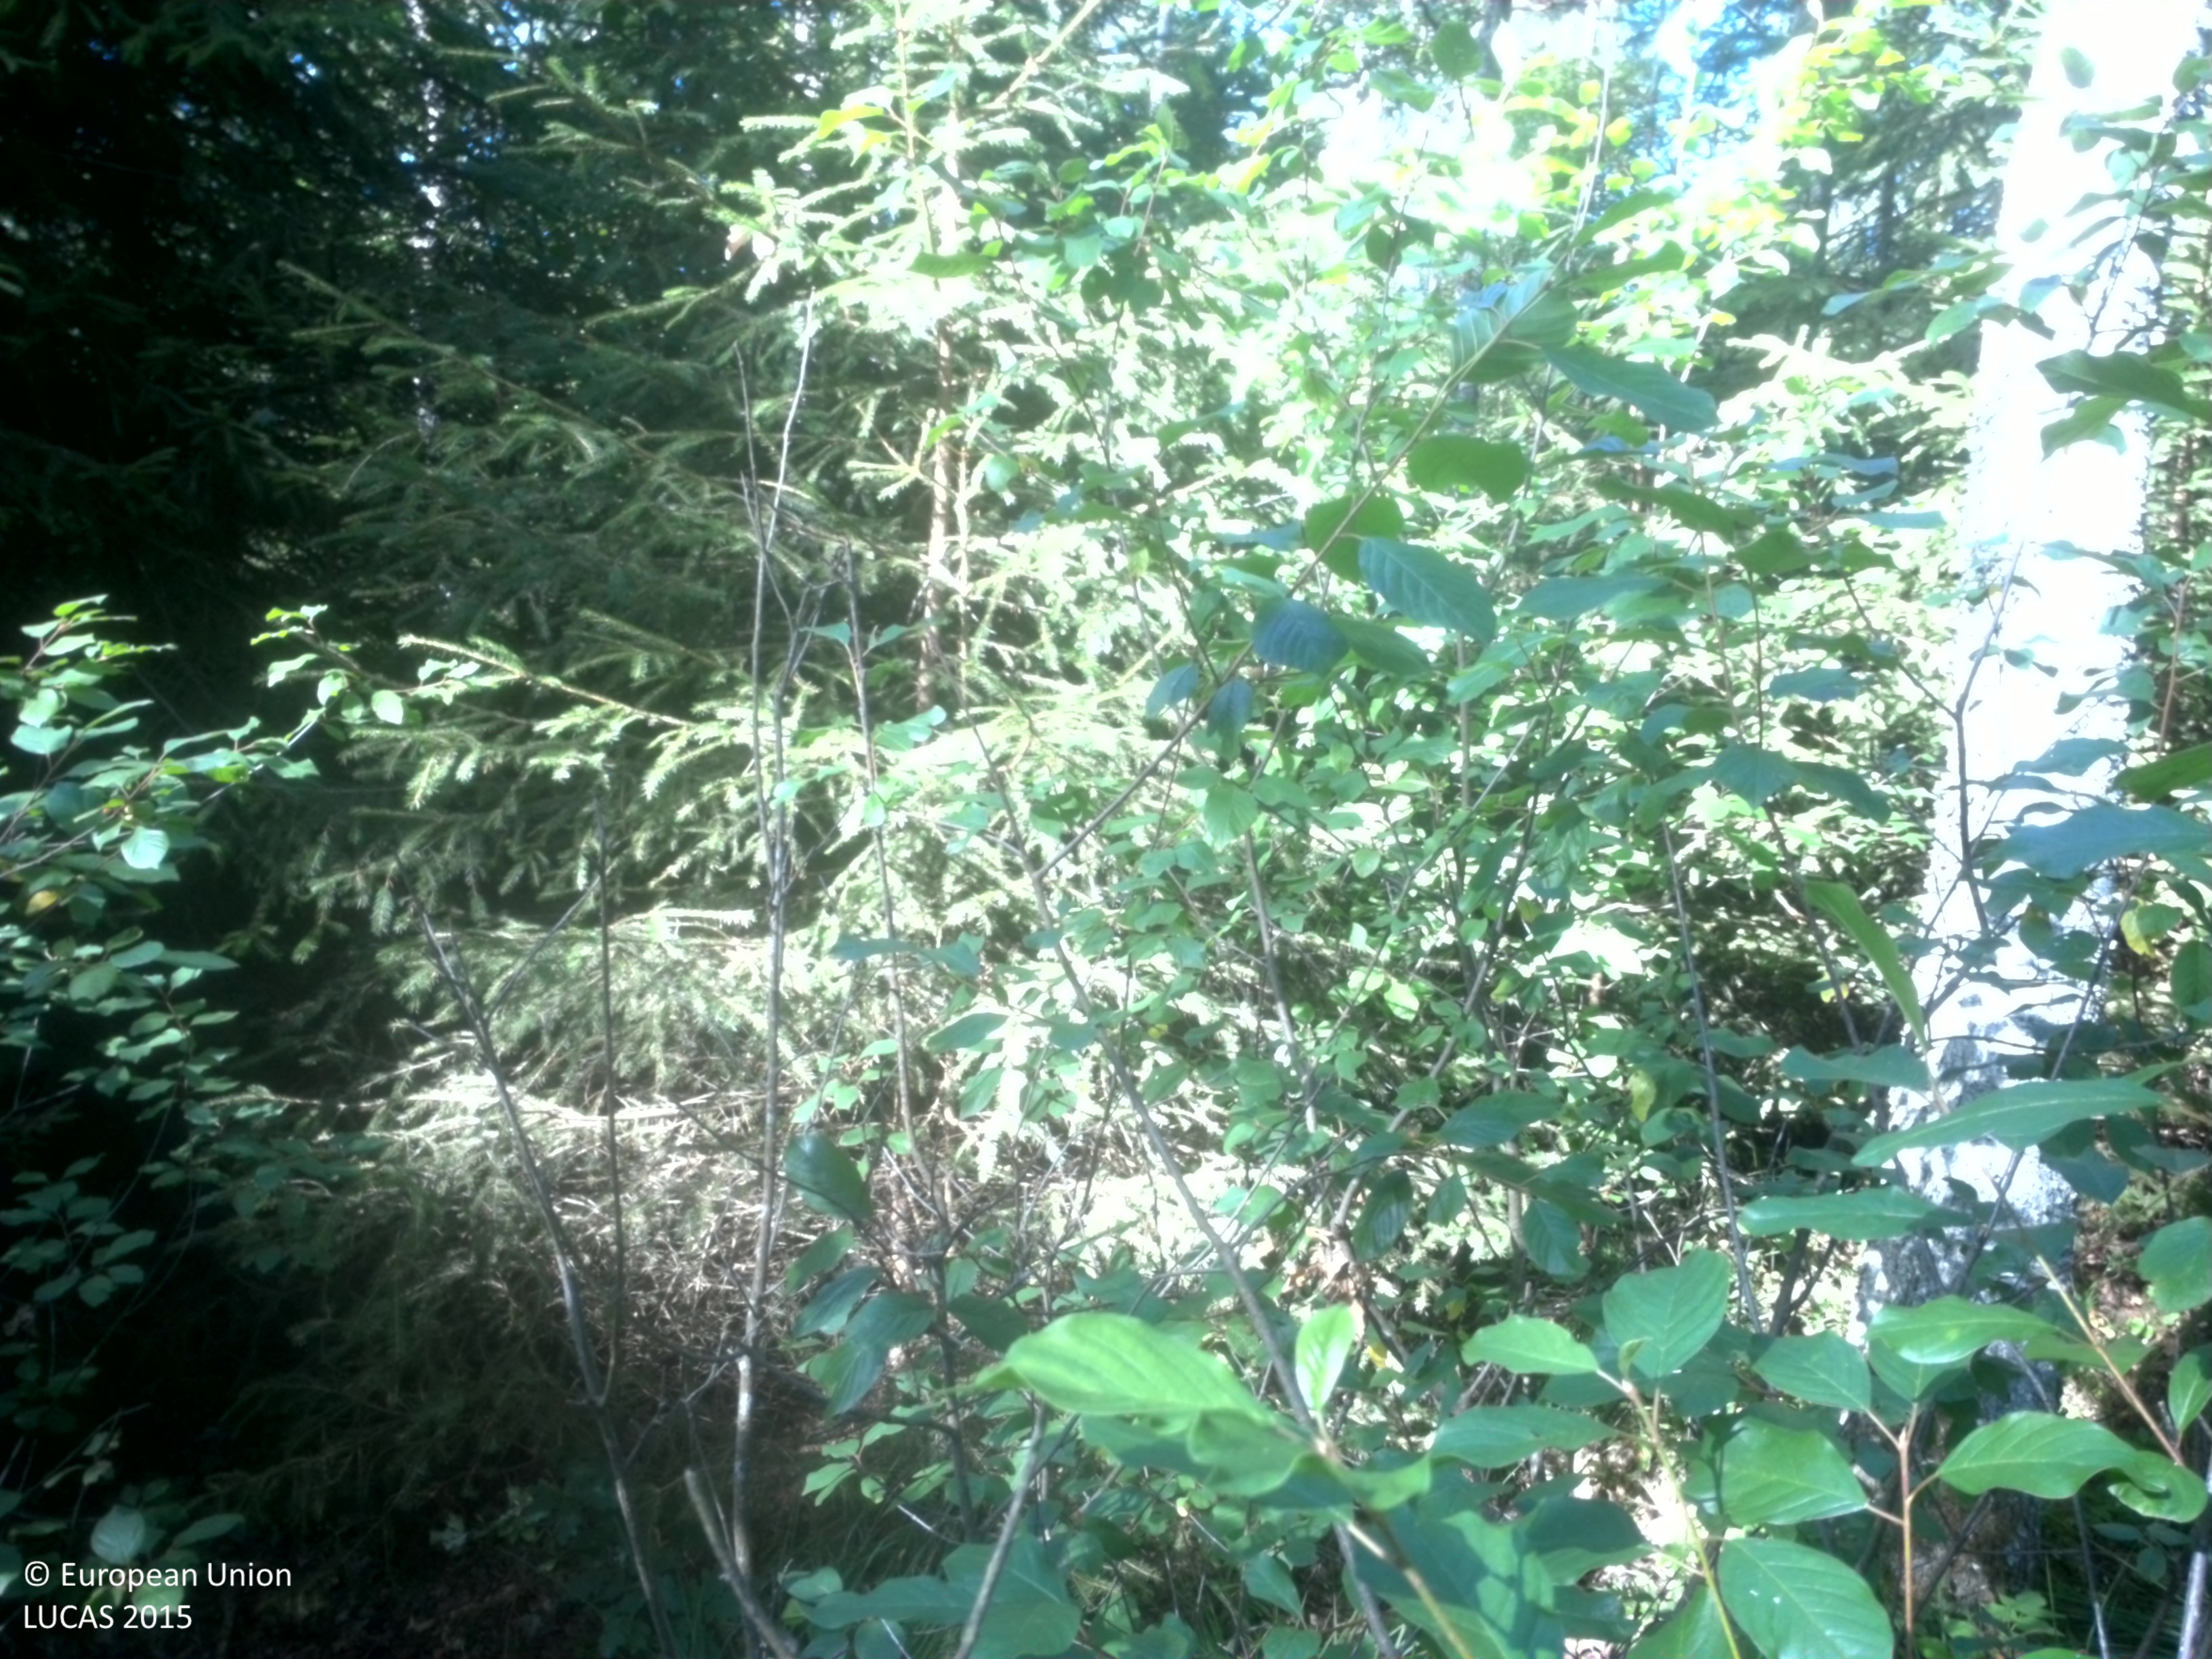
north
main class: Woodland
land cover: Broadleaved woodland
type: boreal forest
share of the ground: 50 - 75 %
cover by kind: broadleaved forest trees 55 %, herbaceous plants 35 %, coniferous forest trees 5 %, shrubs 5 %
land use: Forestry
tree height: > 5 m
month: August
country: SE
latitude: 58.2865
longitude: 13.3203
